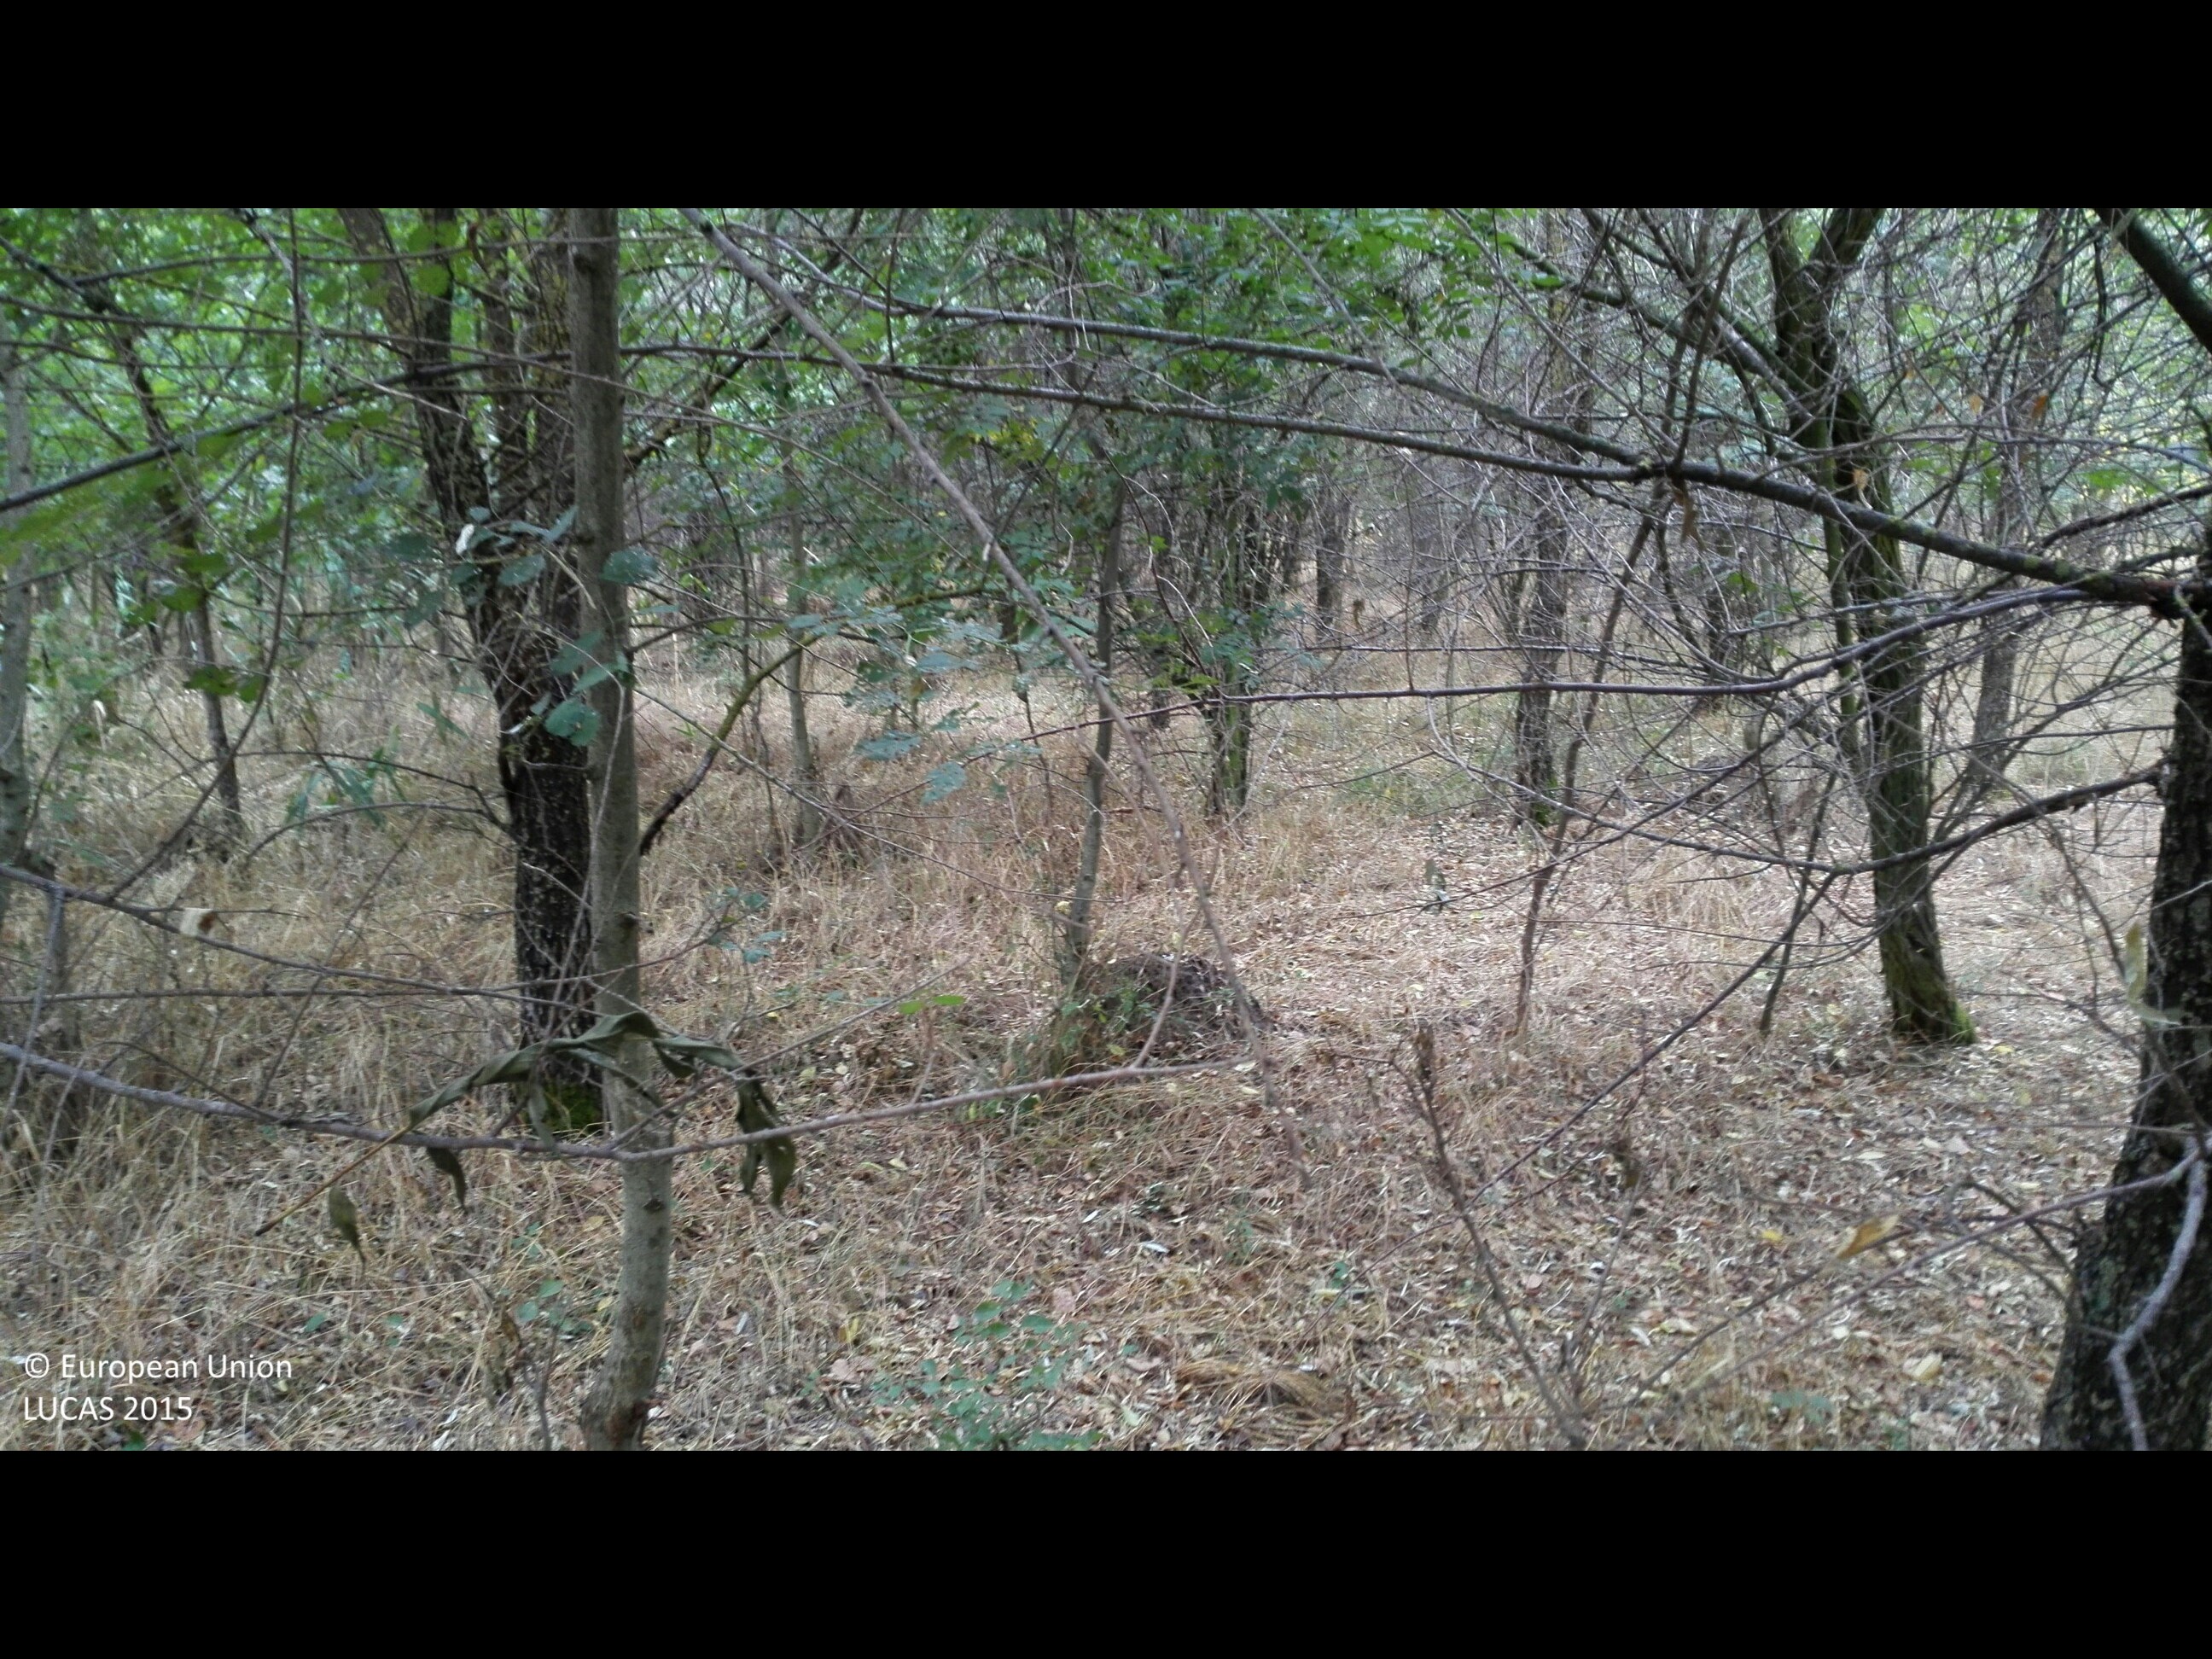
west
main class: Woodland
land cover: Broadleaved woodland
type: acidophilous oak and oak-birch forest
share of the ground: > 75 %
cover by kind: broadleaved forest trees 95 %, herbaceous plants 5 %
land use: Forestry
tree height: > 5 m
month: August
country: HU
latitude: 47.2457
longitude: 21.7638
